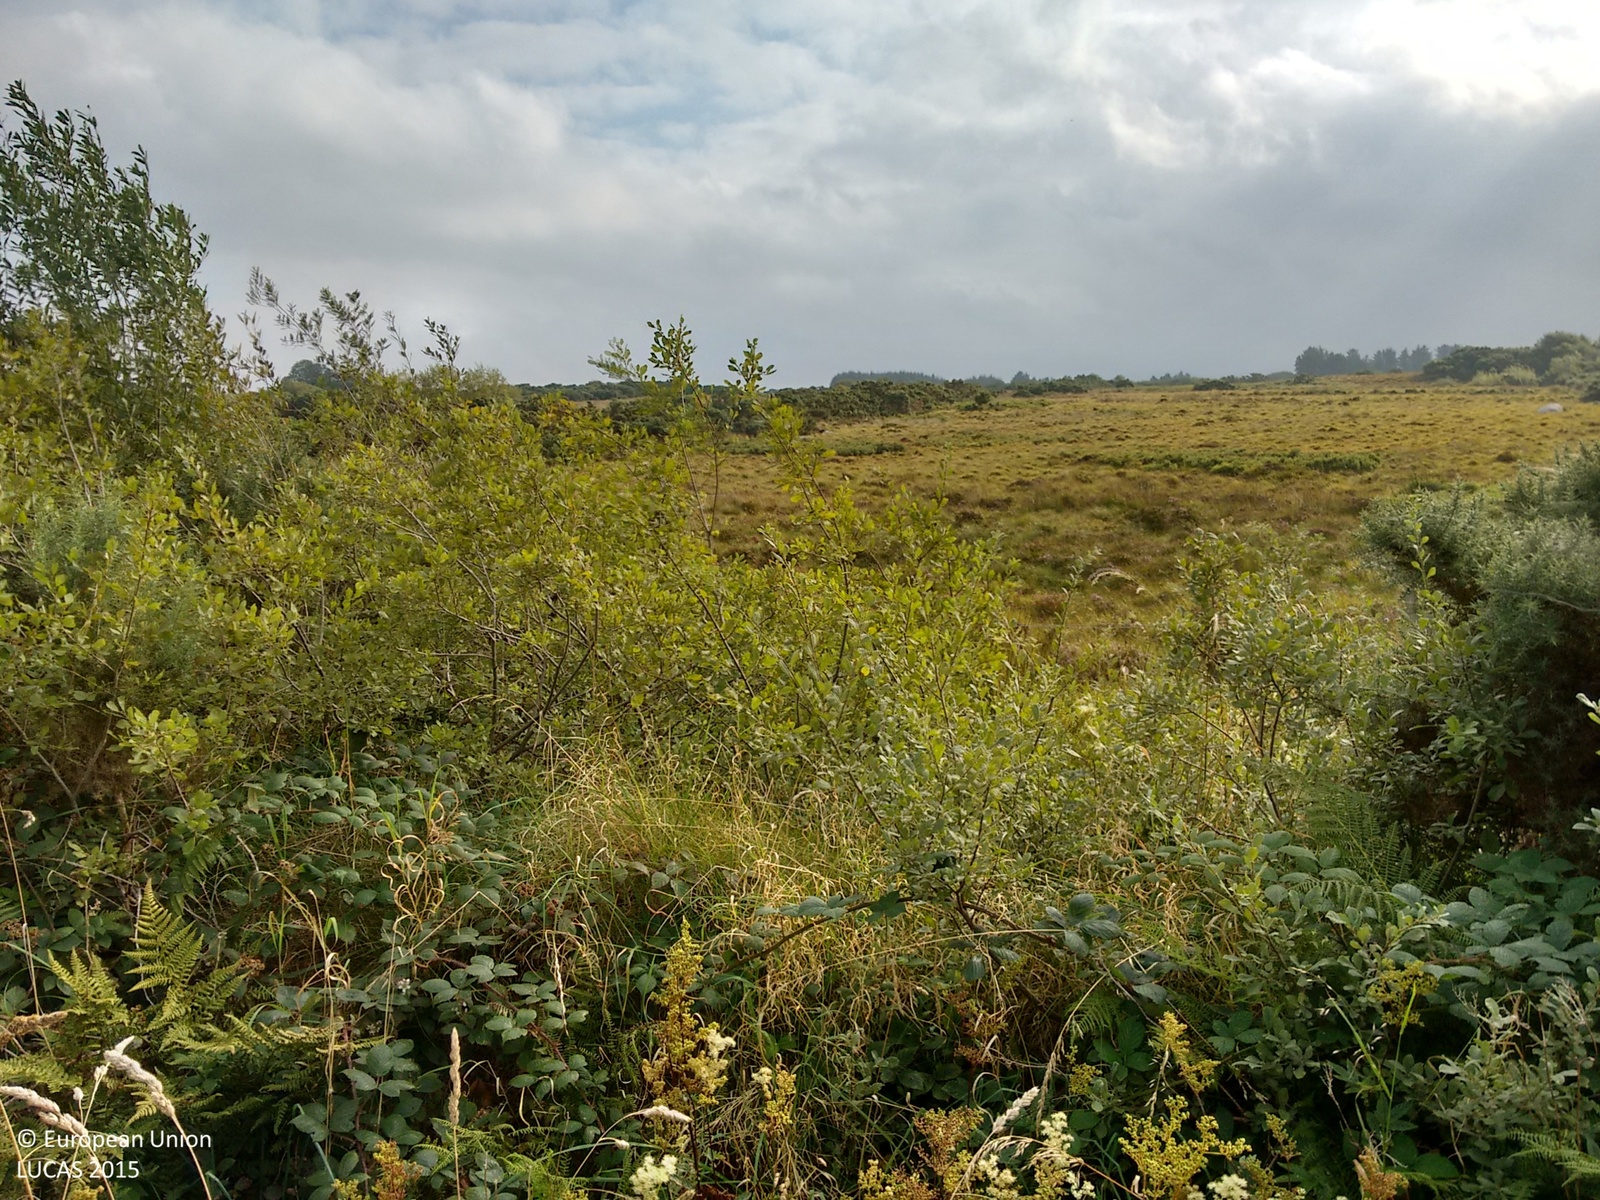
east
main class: Shrubland
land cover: Shrubland without tree cover
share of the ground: > 75 %
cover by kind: shrubs 80 %, herbaceous plants 20 %
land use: Semi-natural and natural areas not in use
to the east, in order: Shrubland without tree cover; Broadleaved woodland; Paved roads, cycling and walking lanes; Broadleaved woodland; Shrubland without tree cover
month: September
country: IE
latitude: 54.1148
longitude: -9.0128
